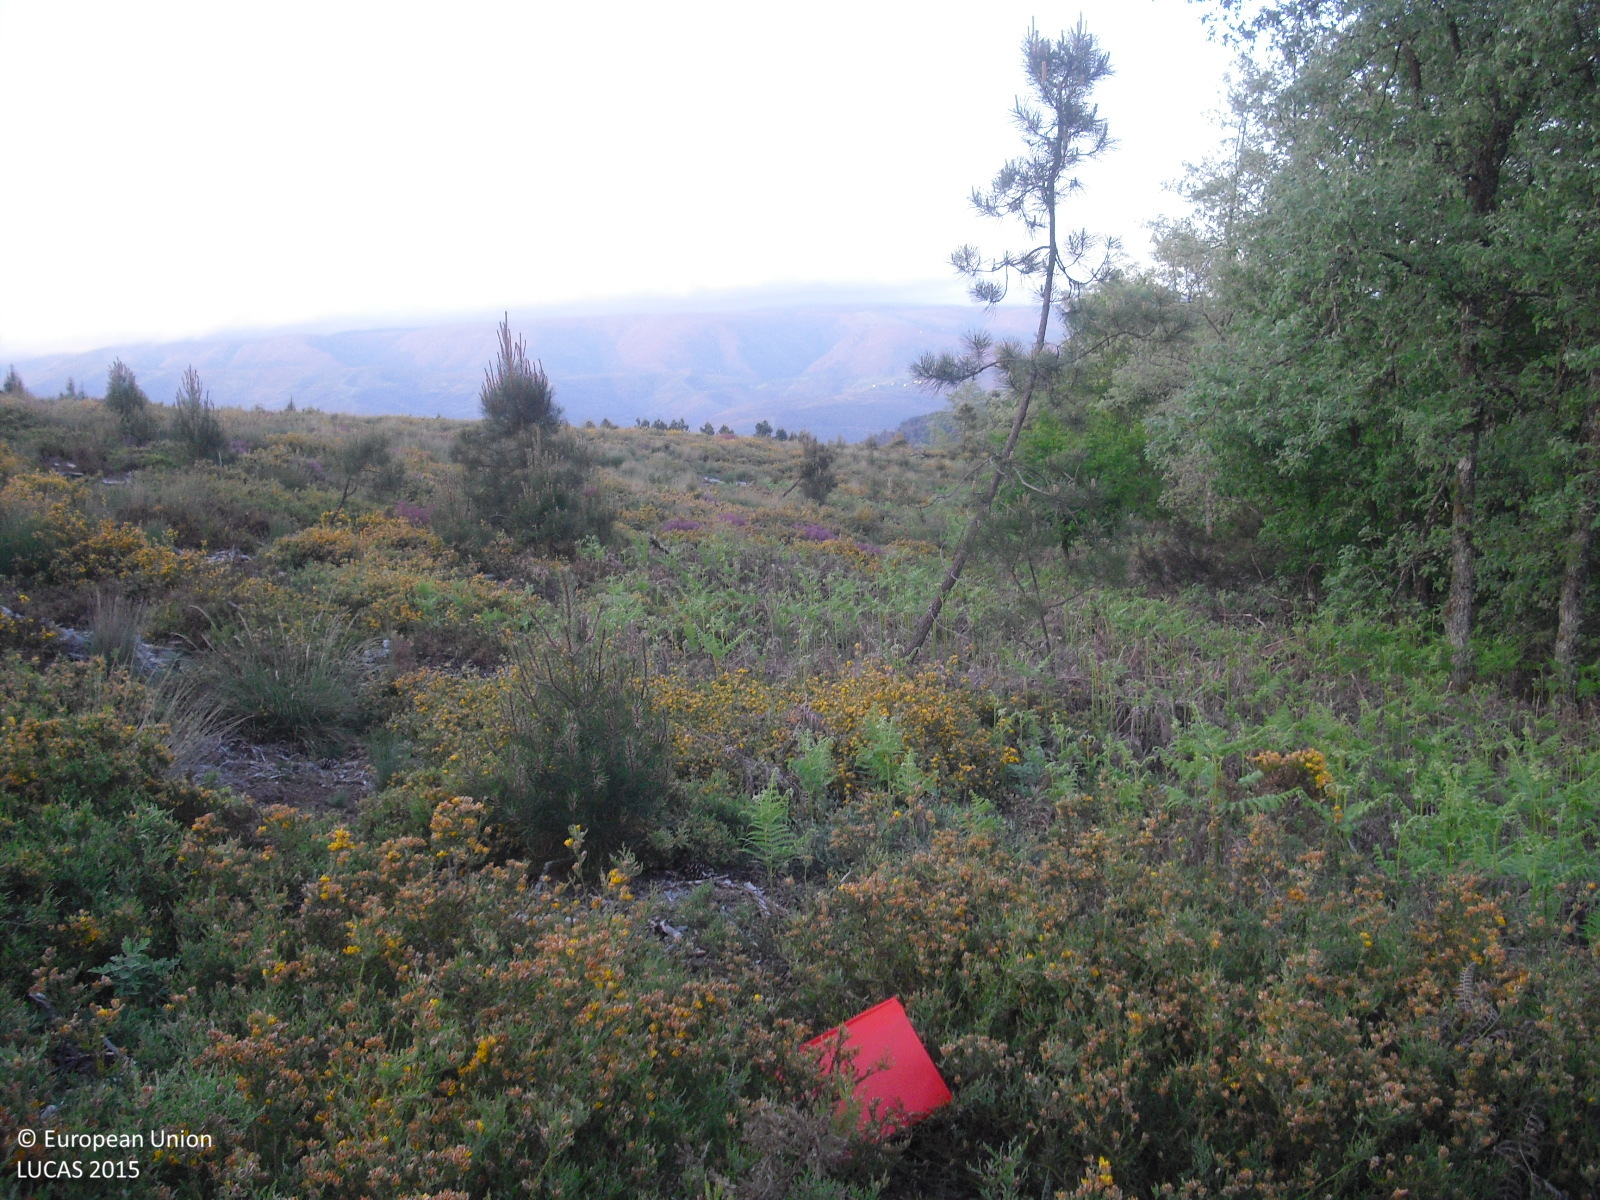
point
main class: Shrubland
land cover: Shrubland with sparse tree cover
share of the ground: > 75 %
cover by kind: shrubs 70 %, unconsolidated bare surface 25 %, broadleaved forest trees 5 %
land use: Forestry
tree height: < 5 m
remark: Clear cut
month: May
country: ES
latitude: 42.0659
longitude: -7.5521
